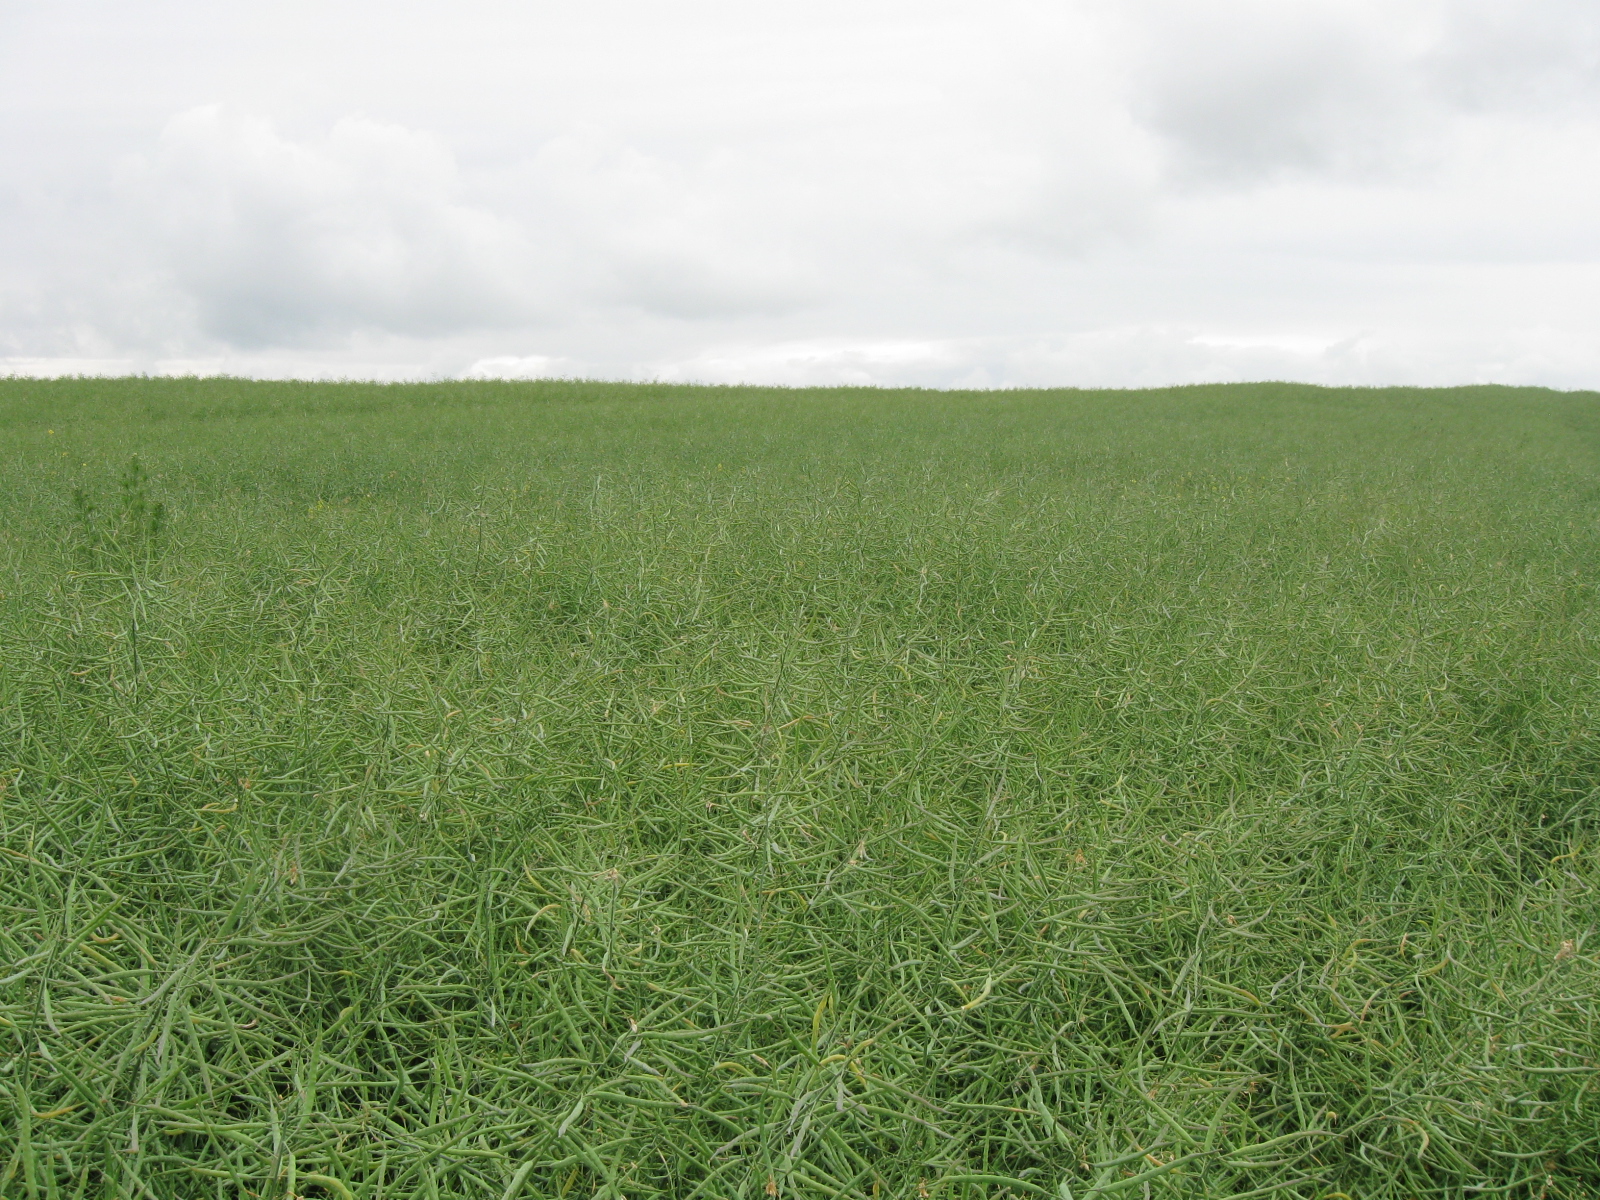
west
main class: Cropland
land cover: Rape and turnip rape
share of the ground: > 75 %
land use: Agriculture (excluding fallow land and kitchen gardens)
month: June
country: LT
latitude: 54.8937
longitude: 24.5569
